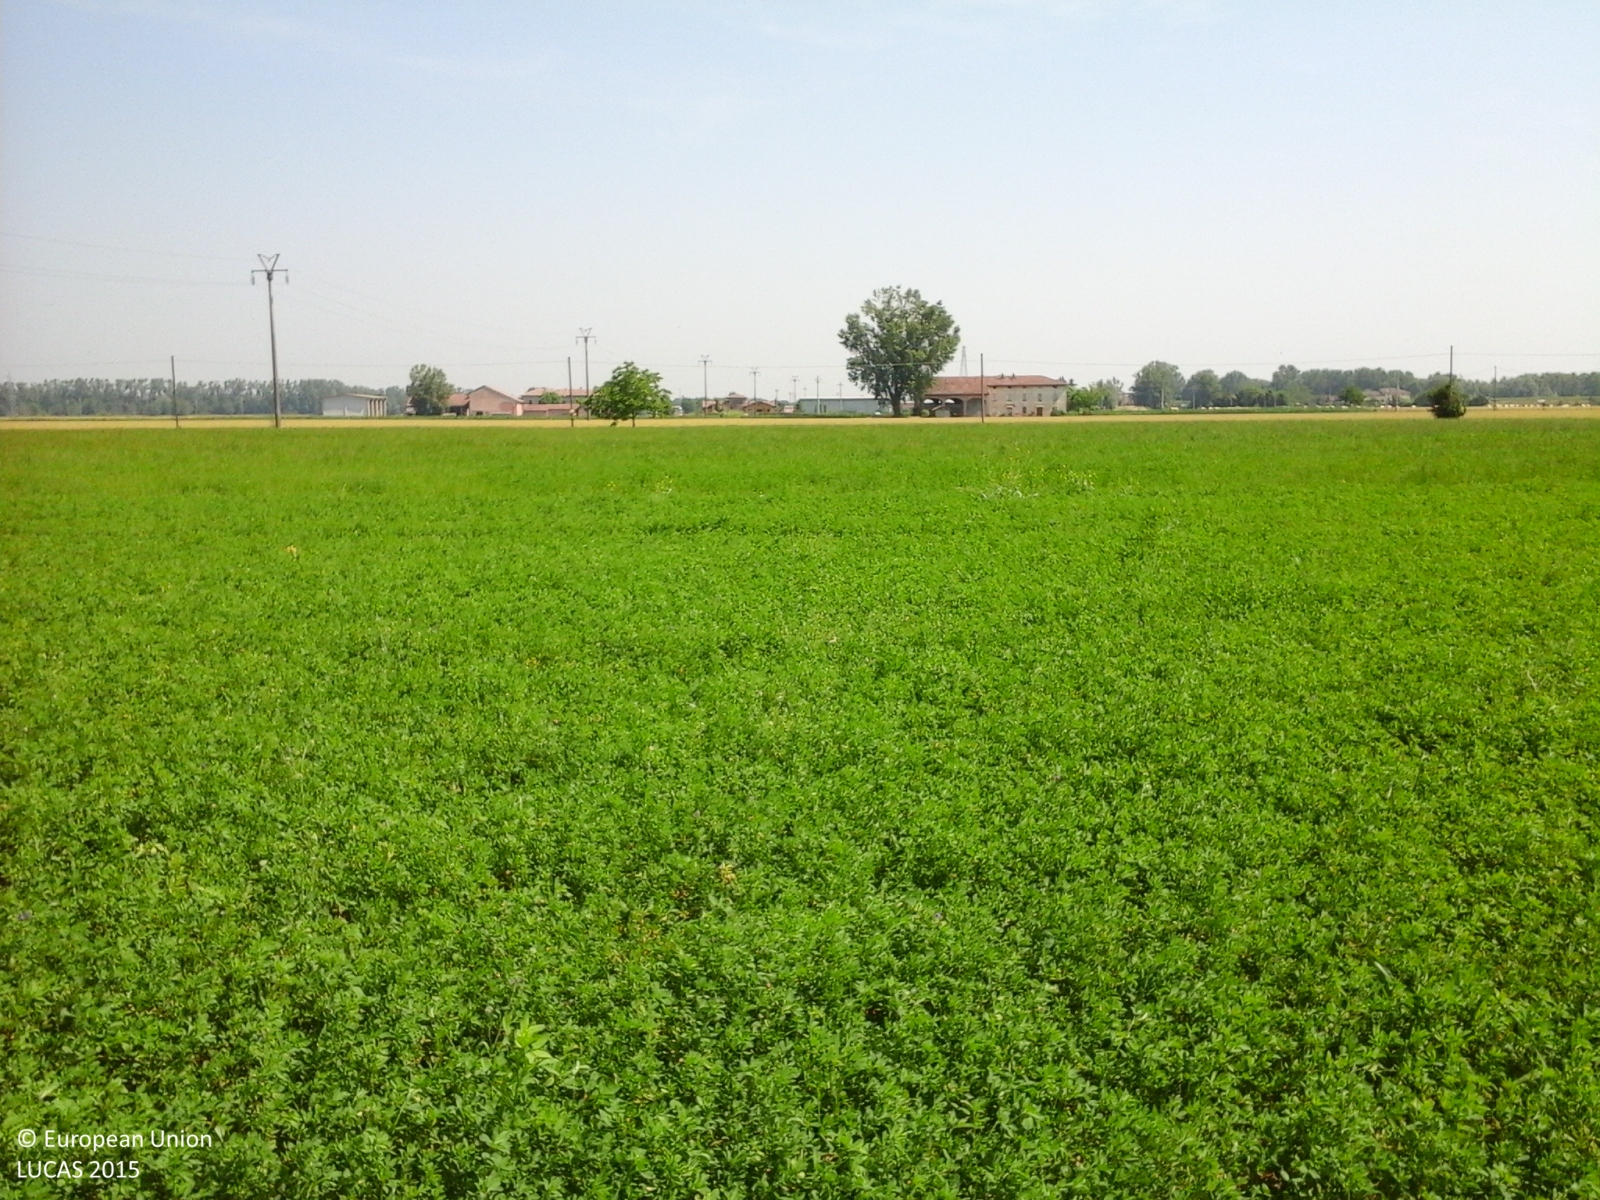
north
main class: Cropland
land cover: Lucerne
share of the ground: > 75 %
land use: Agriculture (excluding fallow land and kitchen gardens)
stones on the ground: < 10 %
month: June
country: IT
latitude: 44.9091
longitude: 10.3160
